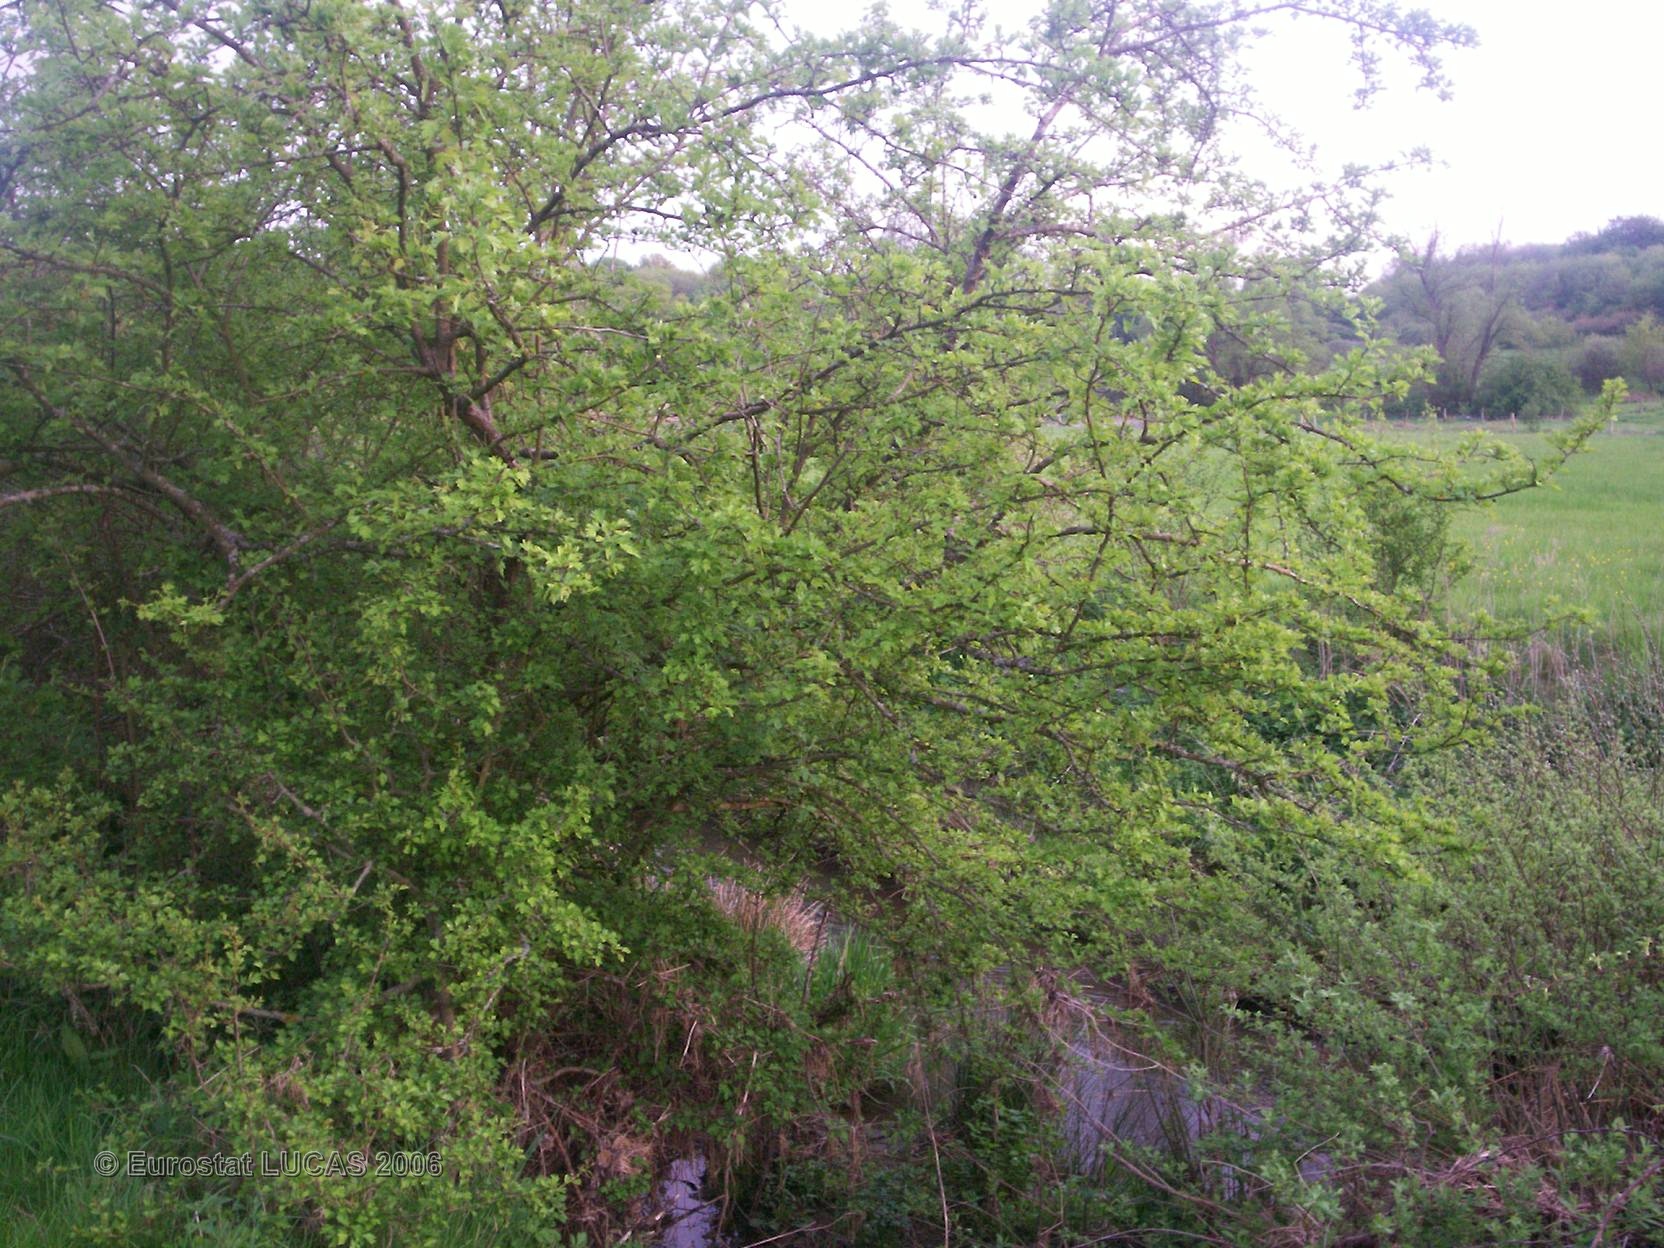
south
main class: Grassland
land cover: Grassland without tree/shrub cover
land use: Agriculture (excluding fallow land and kitchen gardens)
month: May
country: FR
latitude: 48.7588
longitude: 6.9943
